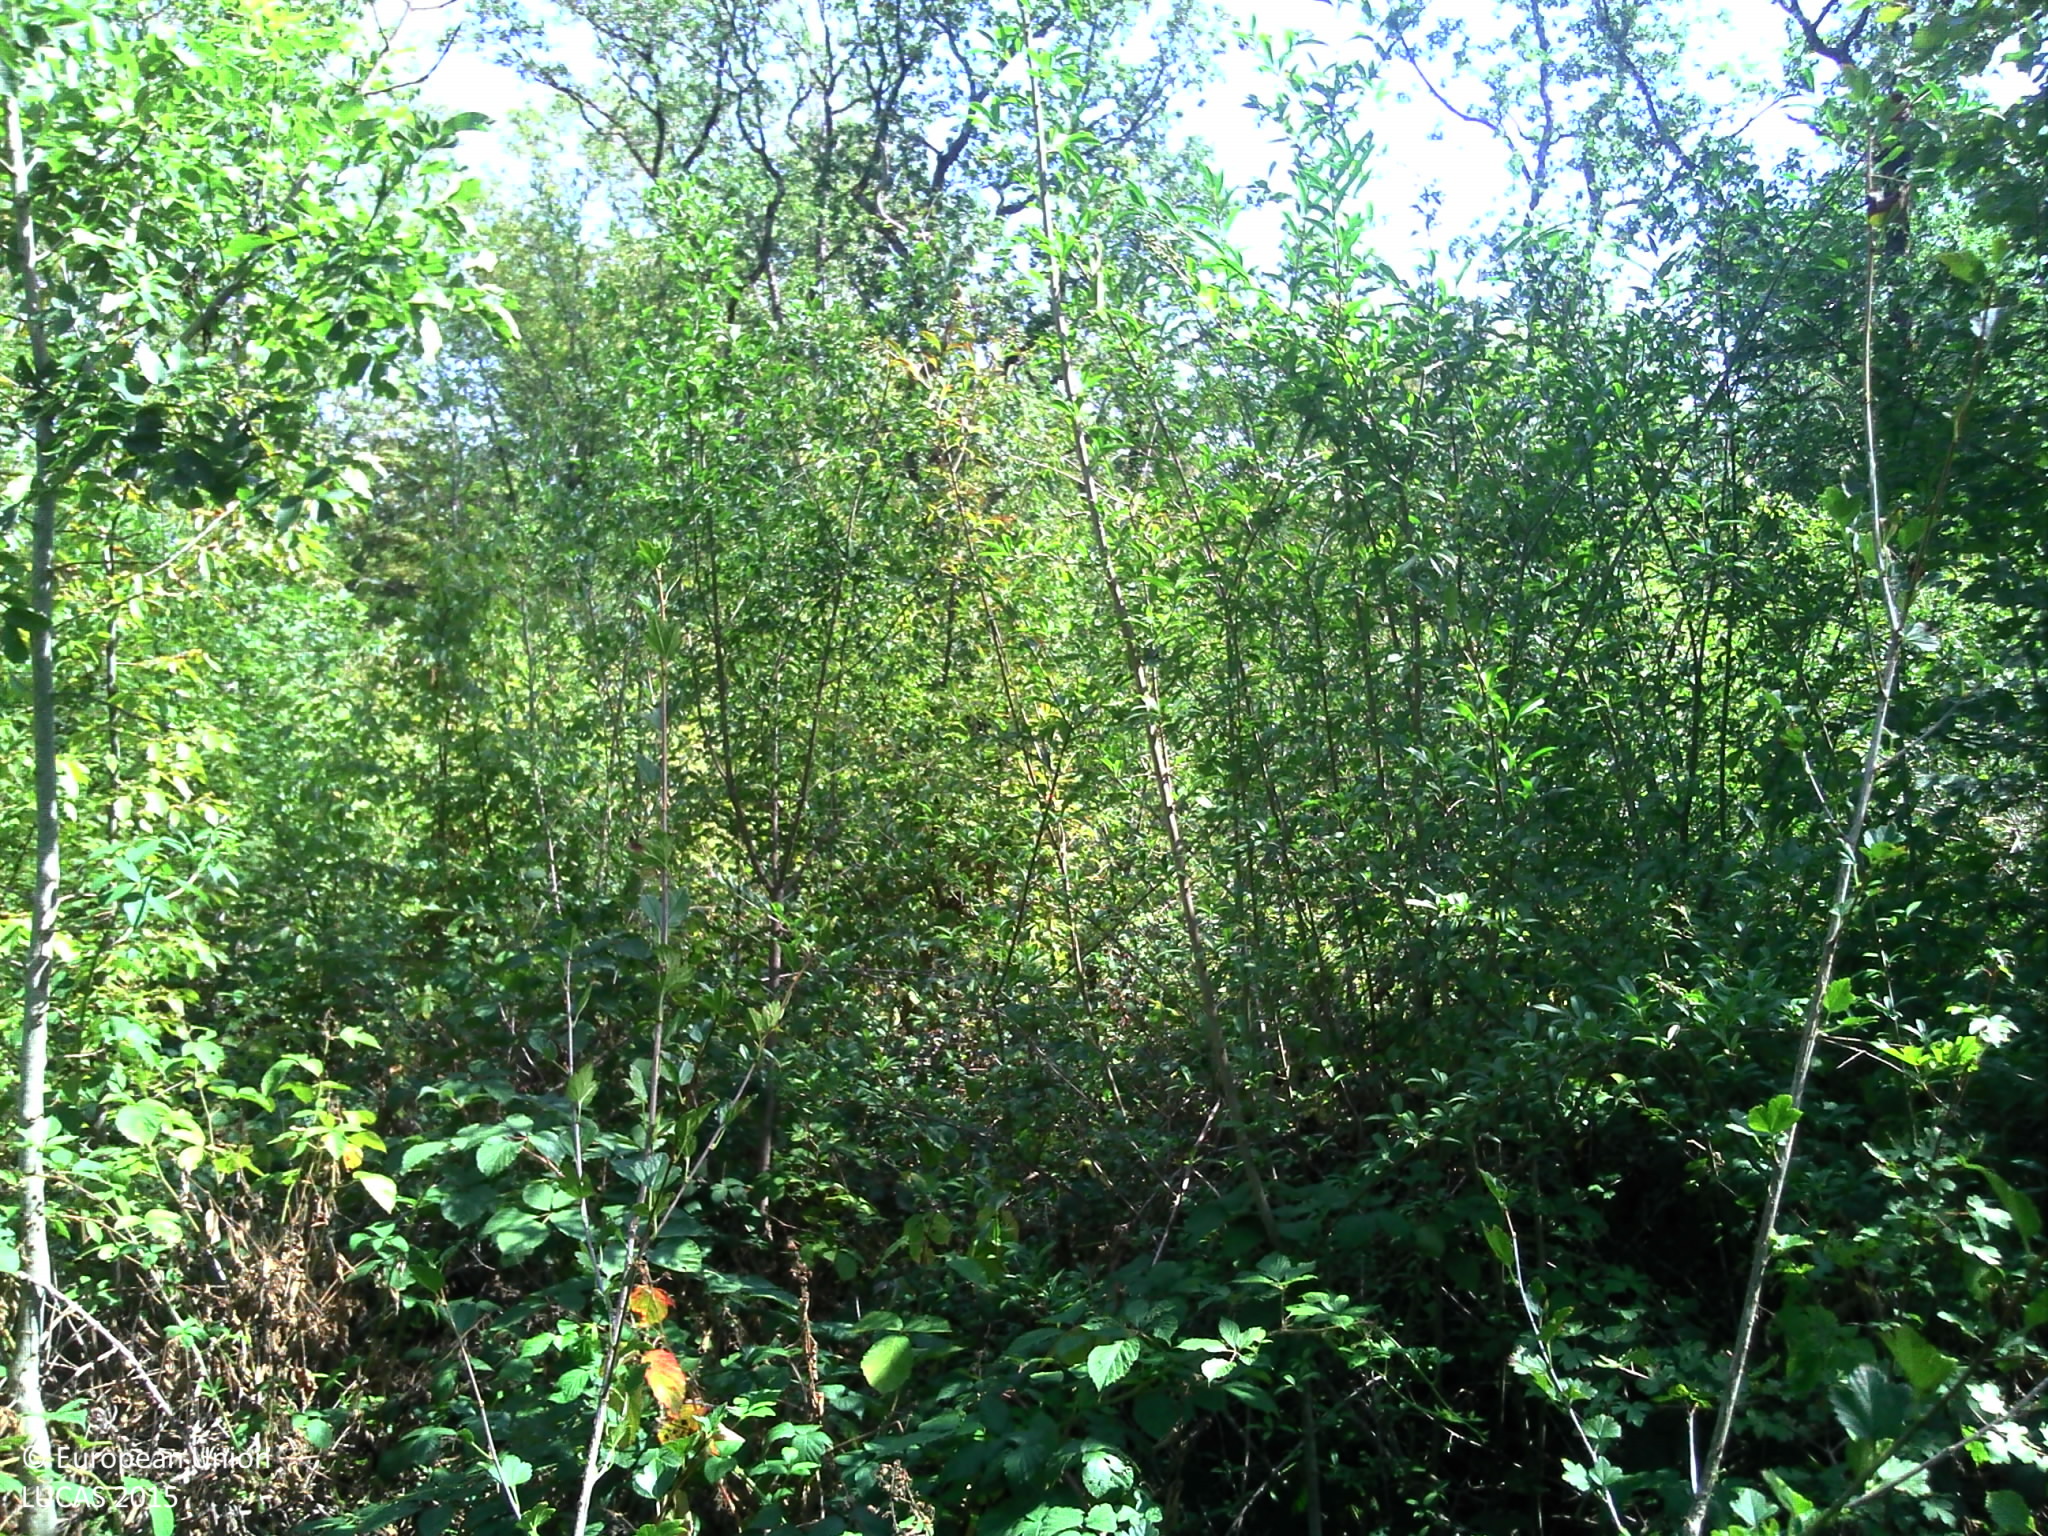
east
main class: Woodland
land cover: Broadleaved woodland
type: mesophytic deciduous forest
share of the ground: > 75 %
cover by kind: broadleaved forest trees 70 %, shrubs 20 %, herbaceous plants 10 %
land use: Forestry
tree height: > 5 m
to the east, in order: Broadleaved woodland
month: August
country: FR
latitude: 47.2177
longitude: 4.8108
